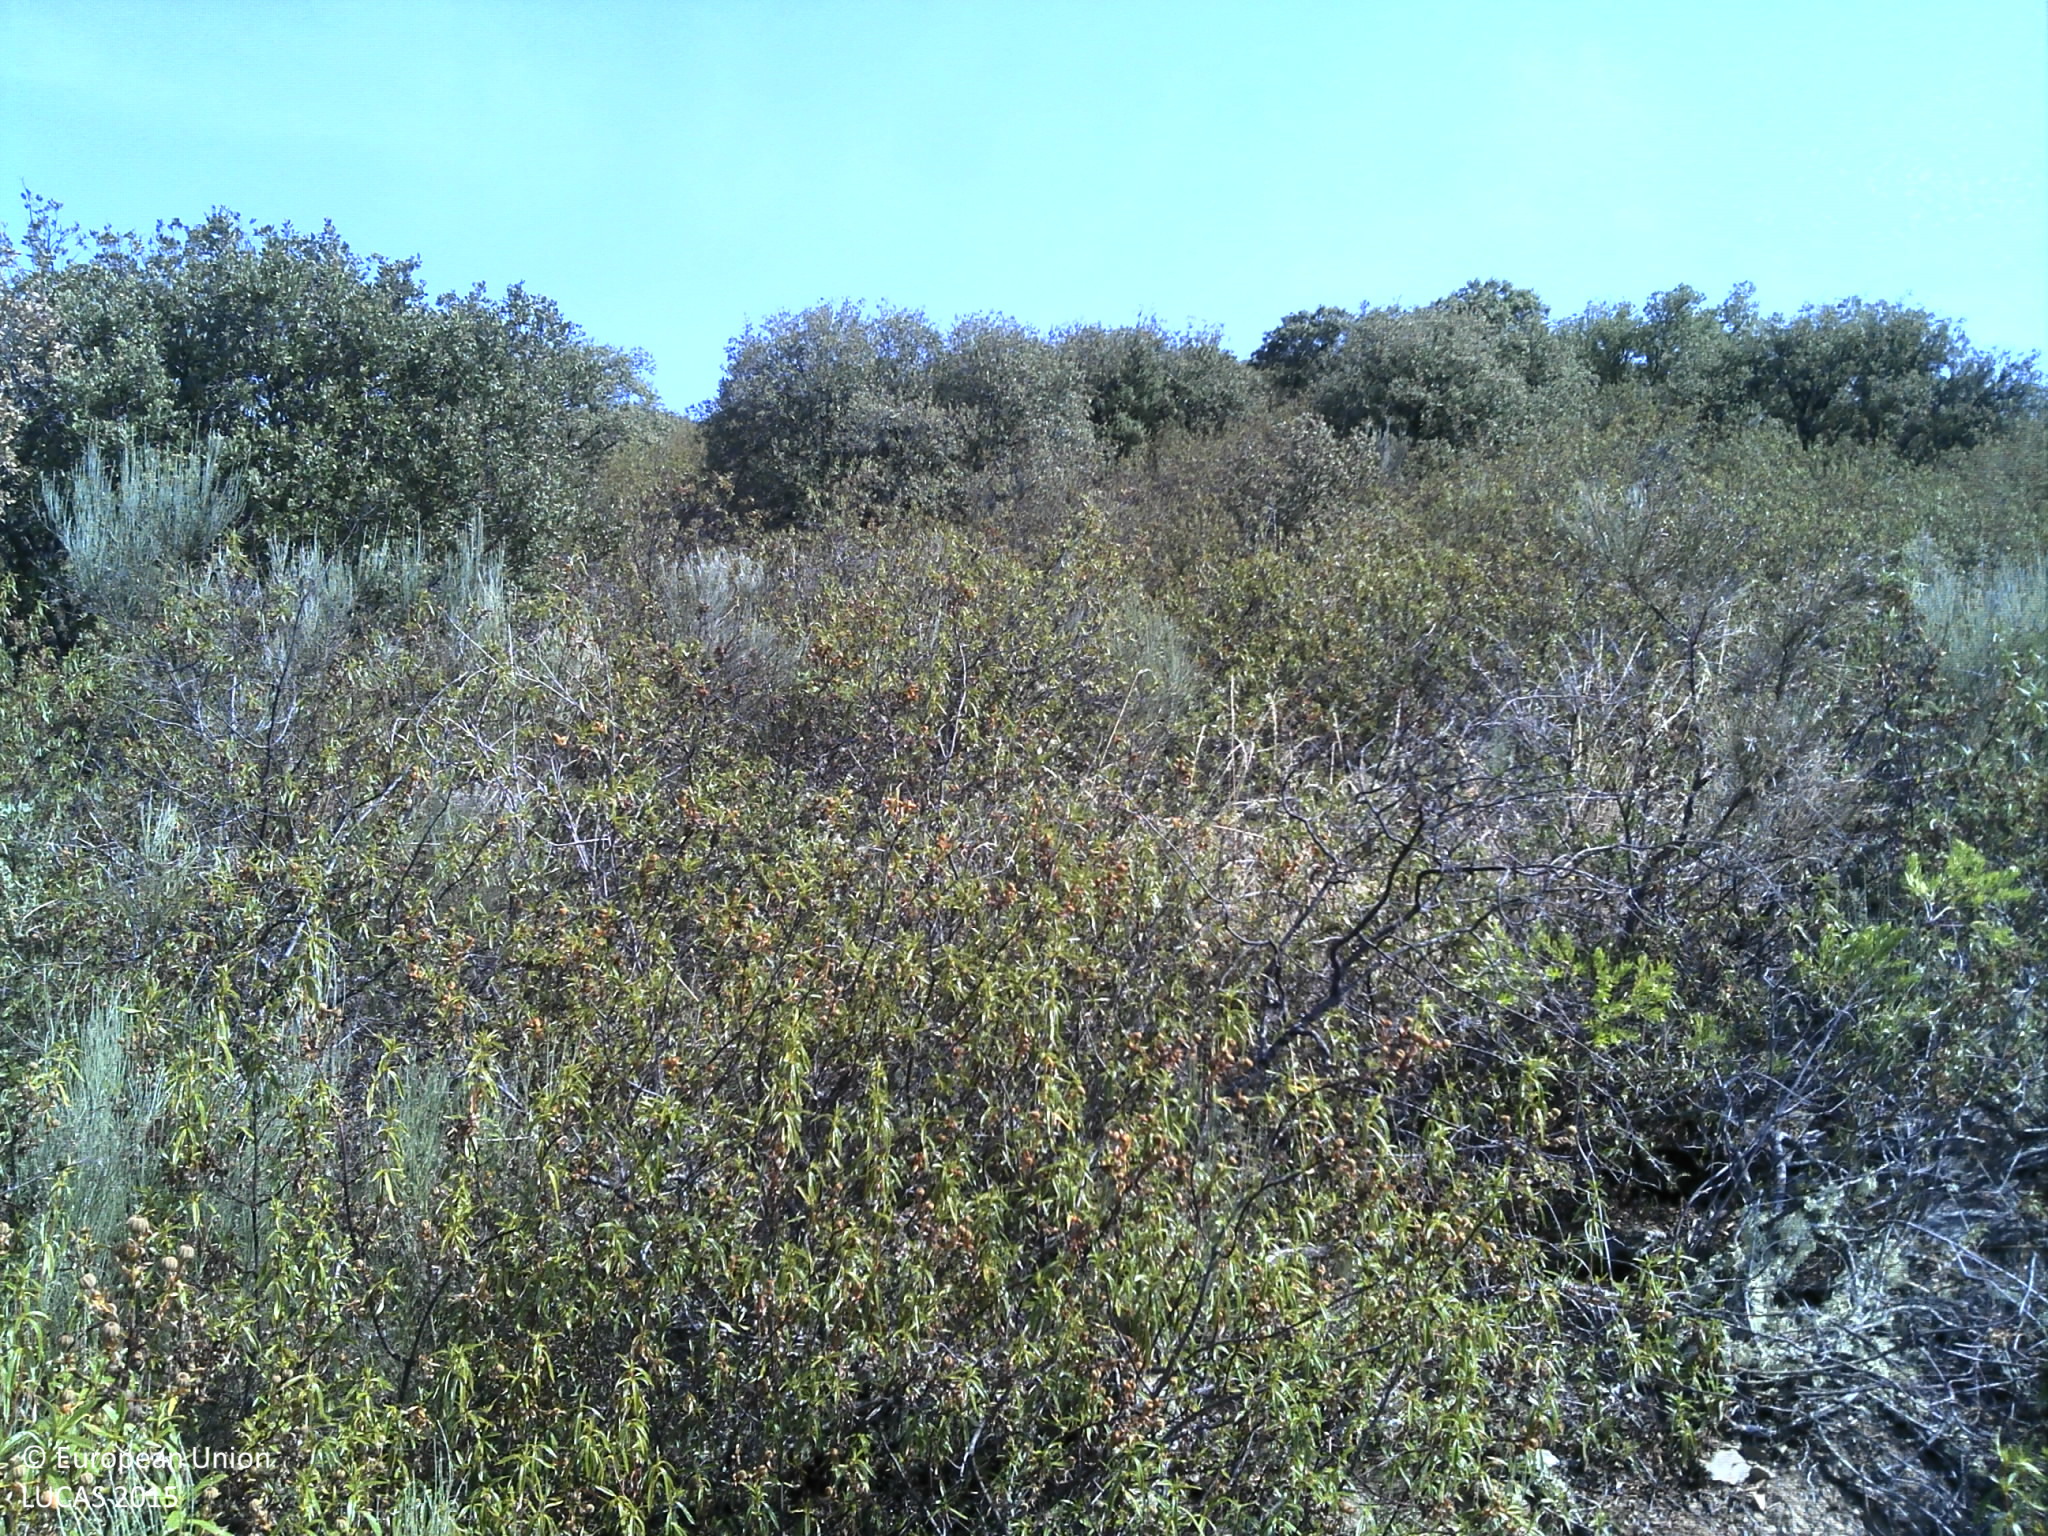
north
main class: Shrubland
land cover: Shrubland with sparse tree cover
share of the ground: > 75 %
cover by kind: shrubs 95 %, broadleaved forest trees 5 %
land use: Semi-natural and natural areas not in use
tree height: < 5 m
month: July
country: PT
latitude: 41.0757
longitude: -7.3143
